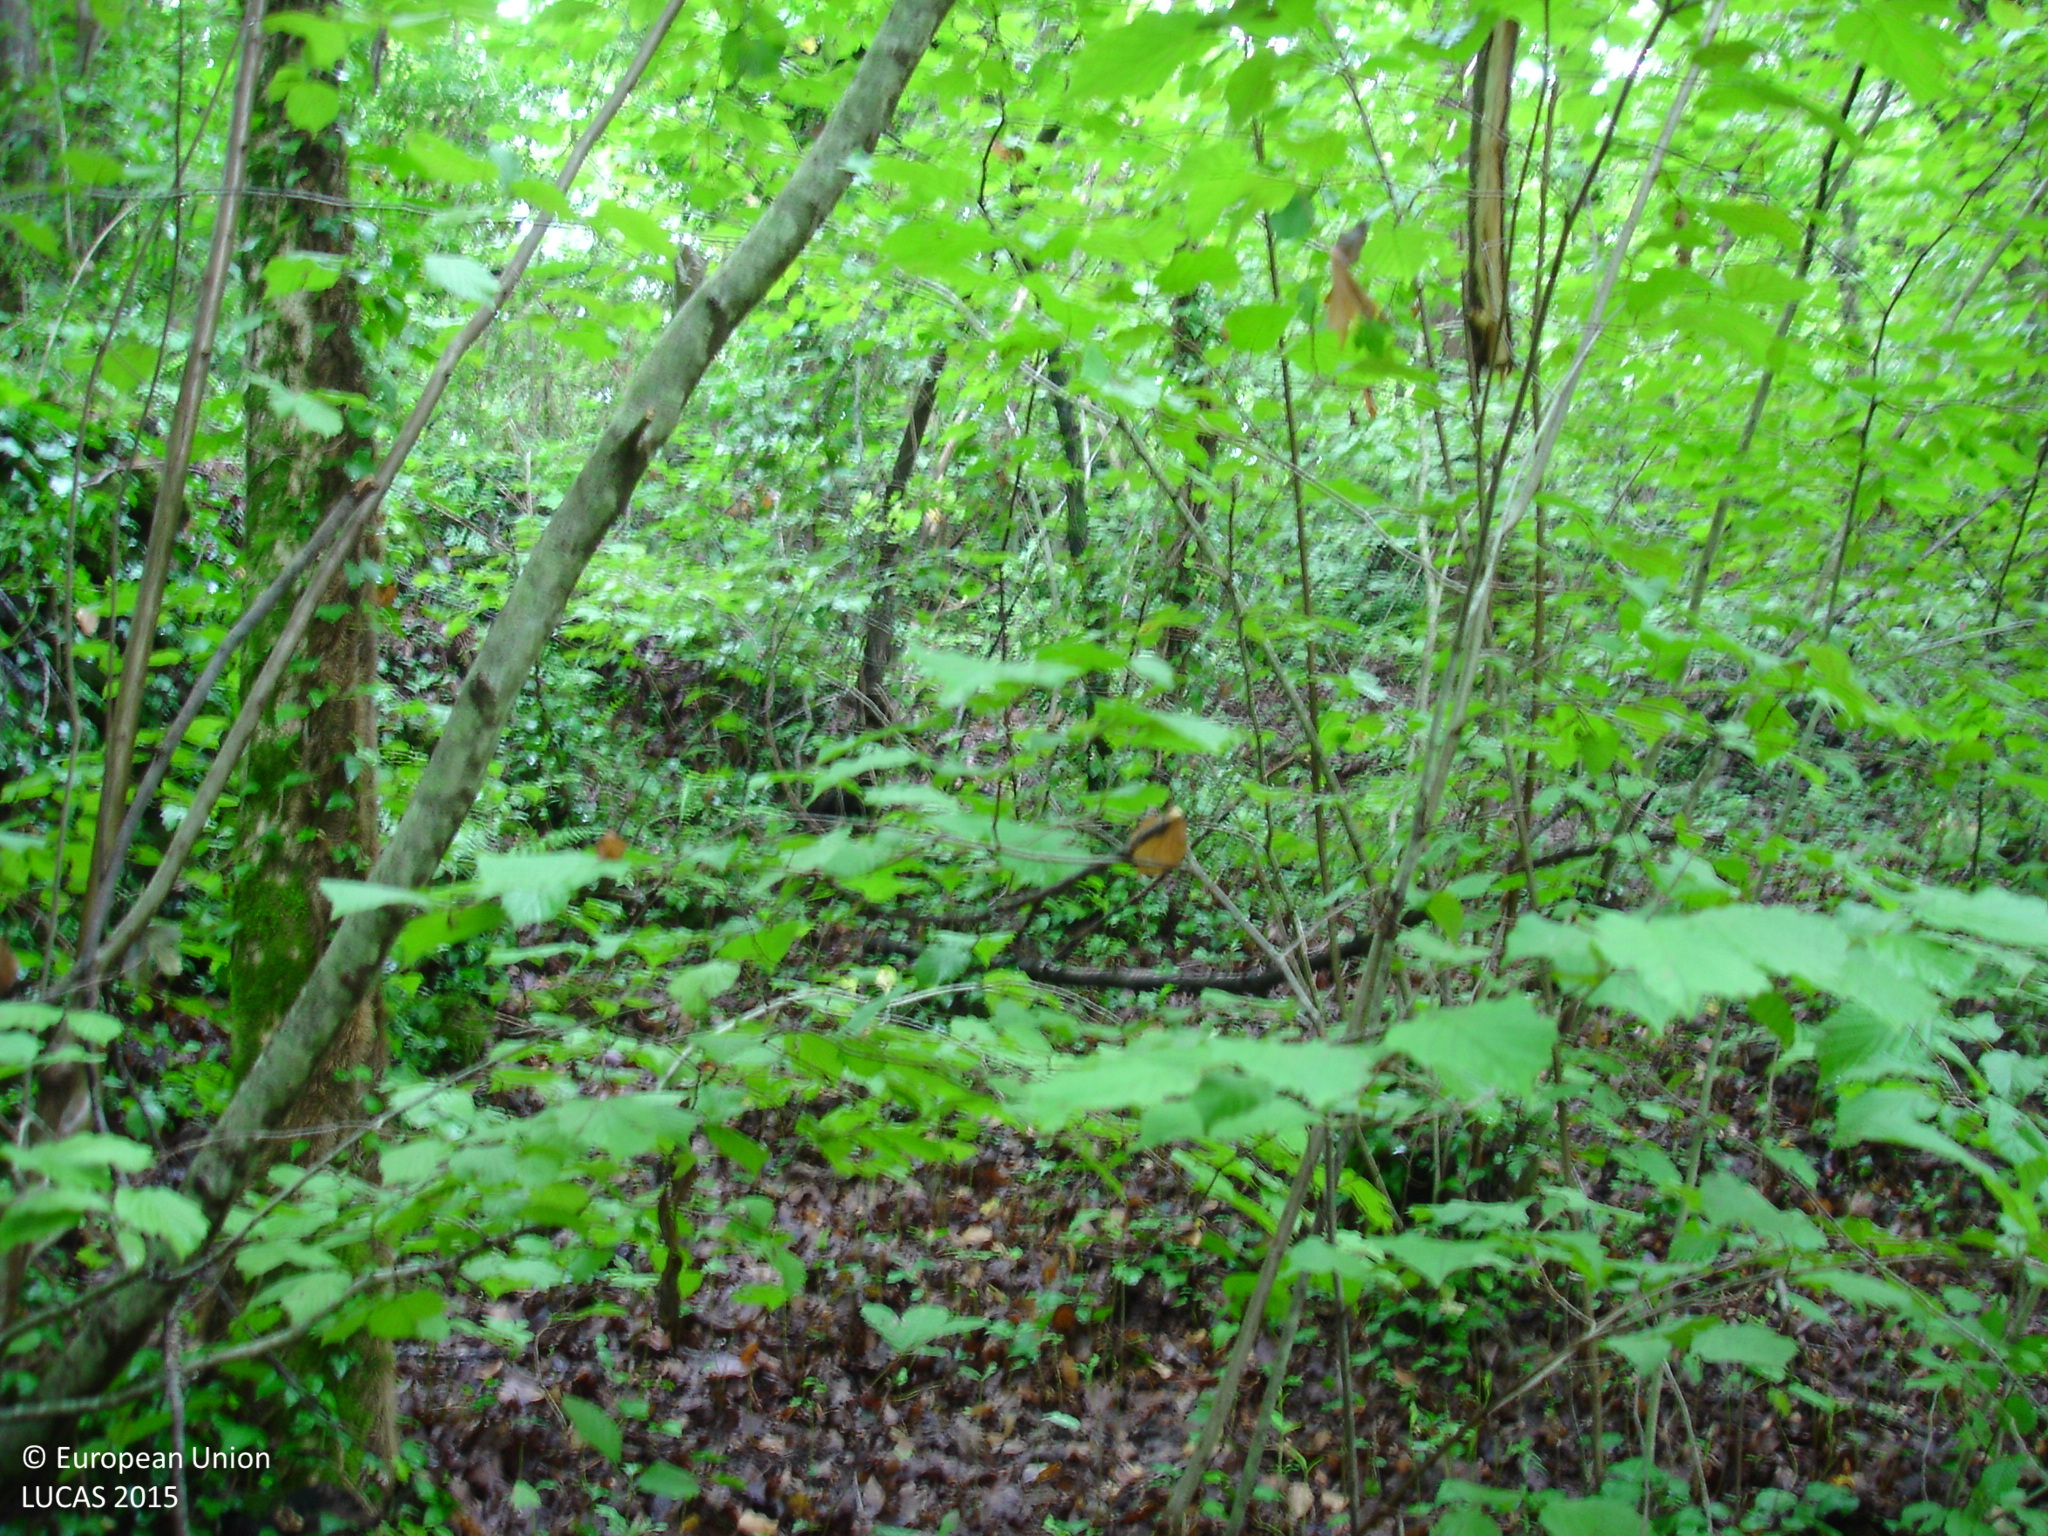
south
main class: Woodland
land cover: Broadleaved woodland
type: thermophilous deciduous forest
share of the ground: > 75 %
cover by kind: broadleaved forest trees 100 %
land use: Forestry
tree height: > 5 m
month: July
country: ES
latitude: 42.1580
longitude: 2.4983
